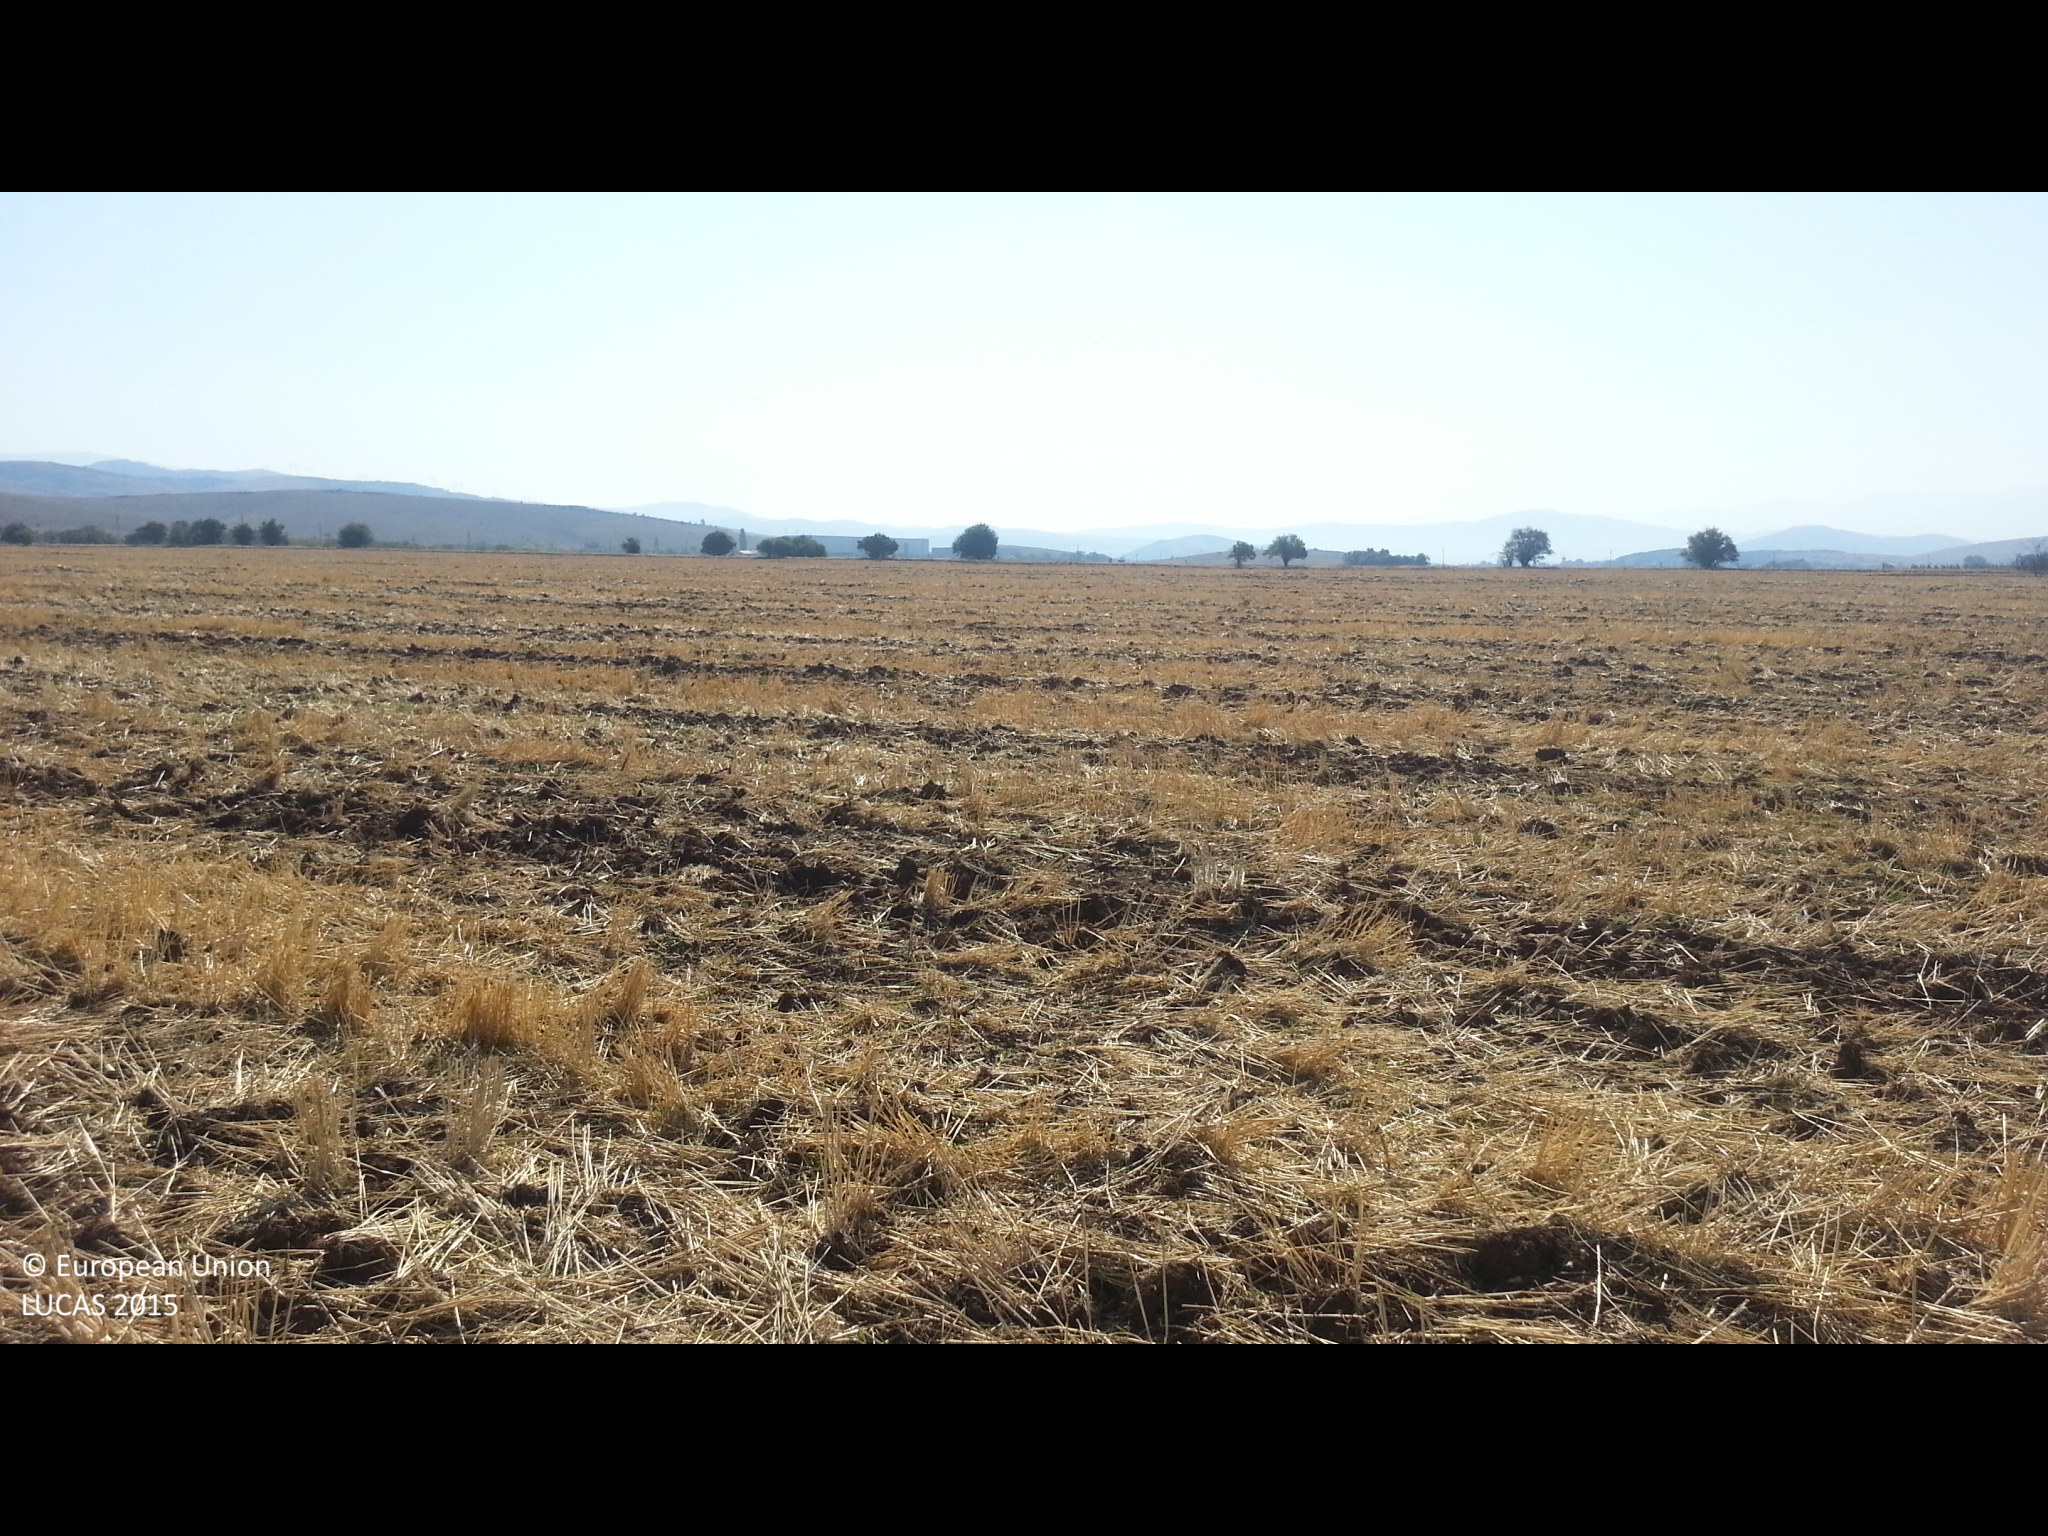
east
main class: Cropland
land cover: Common wheat
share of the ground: 25 - 50 %
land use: Agriculture (excluding fallow land and kitchen gardens)
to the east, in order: Common wheat
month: August
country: BG
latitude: 42.5048
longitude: 23.0129
